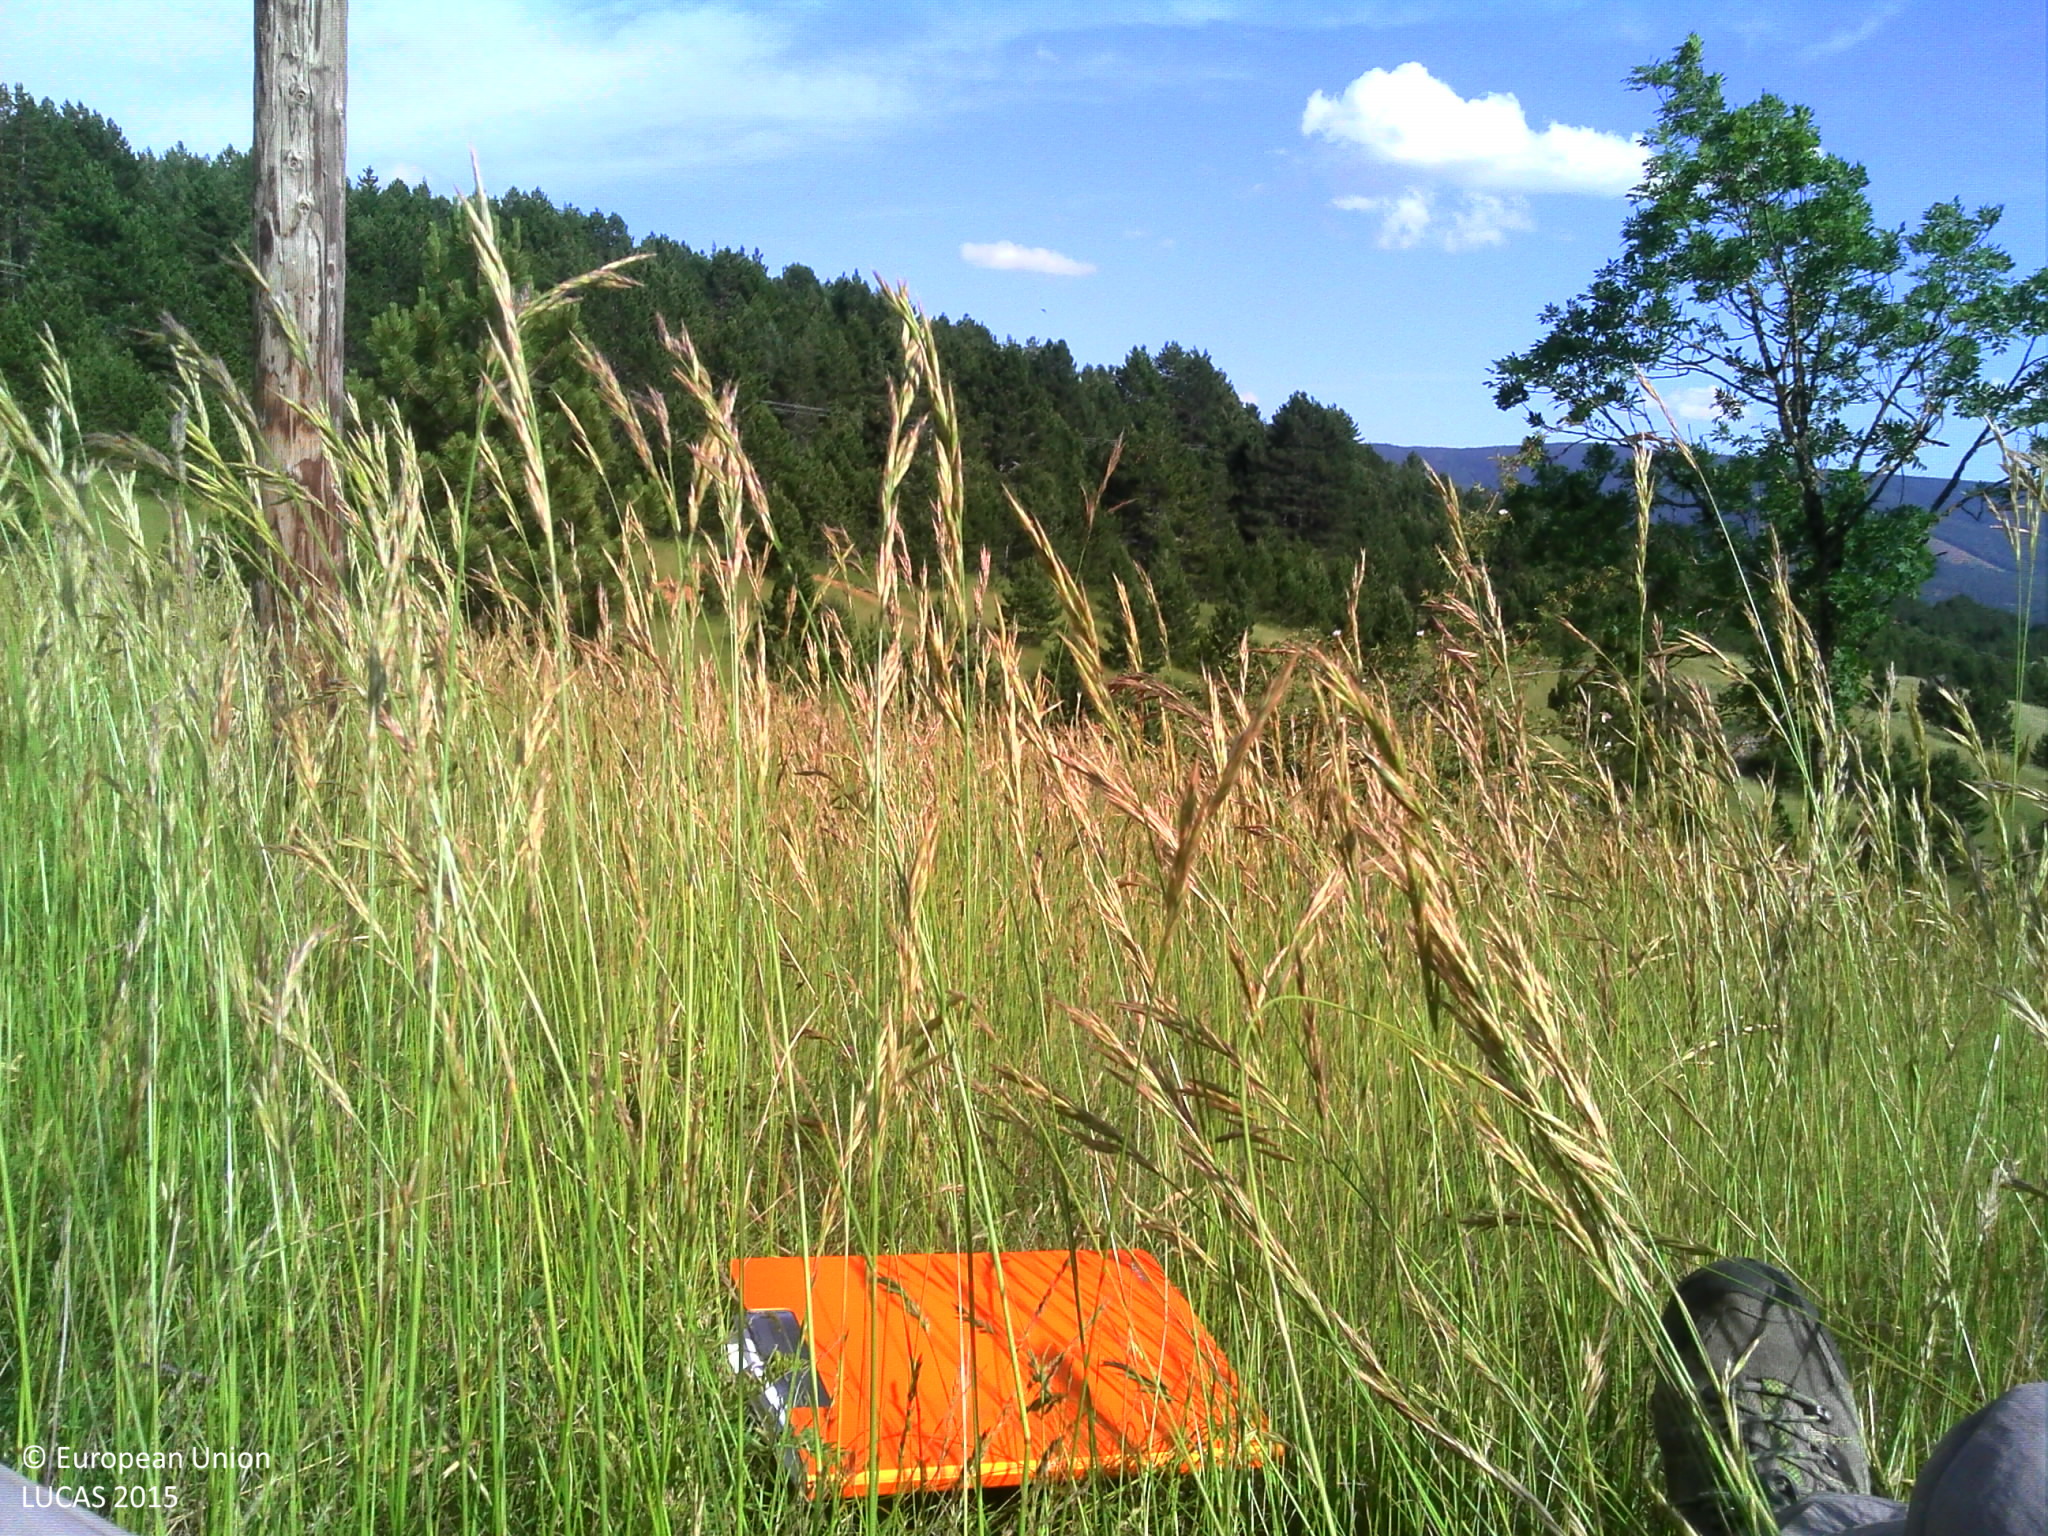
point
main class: Grassland
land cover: Grassland with sparse tree/shrub cover
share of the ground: > 75 %
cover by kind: herbaceous plants 90 %, coniferous forest trees 5 %, shrubs 5 %
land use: Agriculture (excluding fallow land and kitchen gardens)
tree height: < 5 m
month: June
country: FR
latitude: 44.5117
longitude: 3.5520
